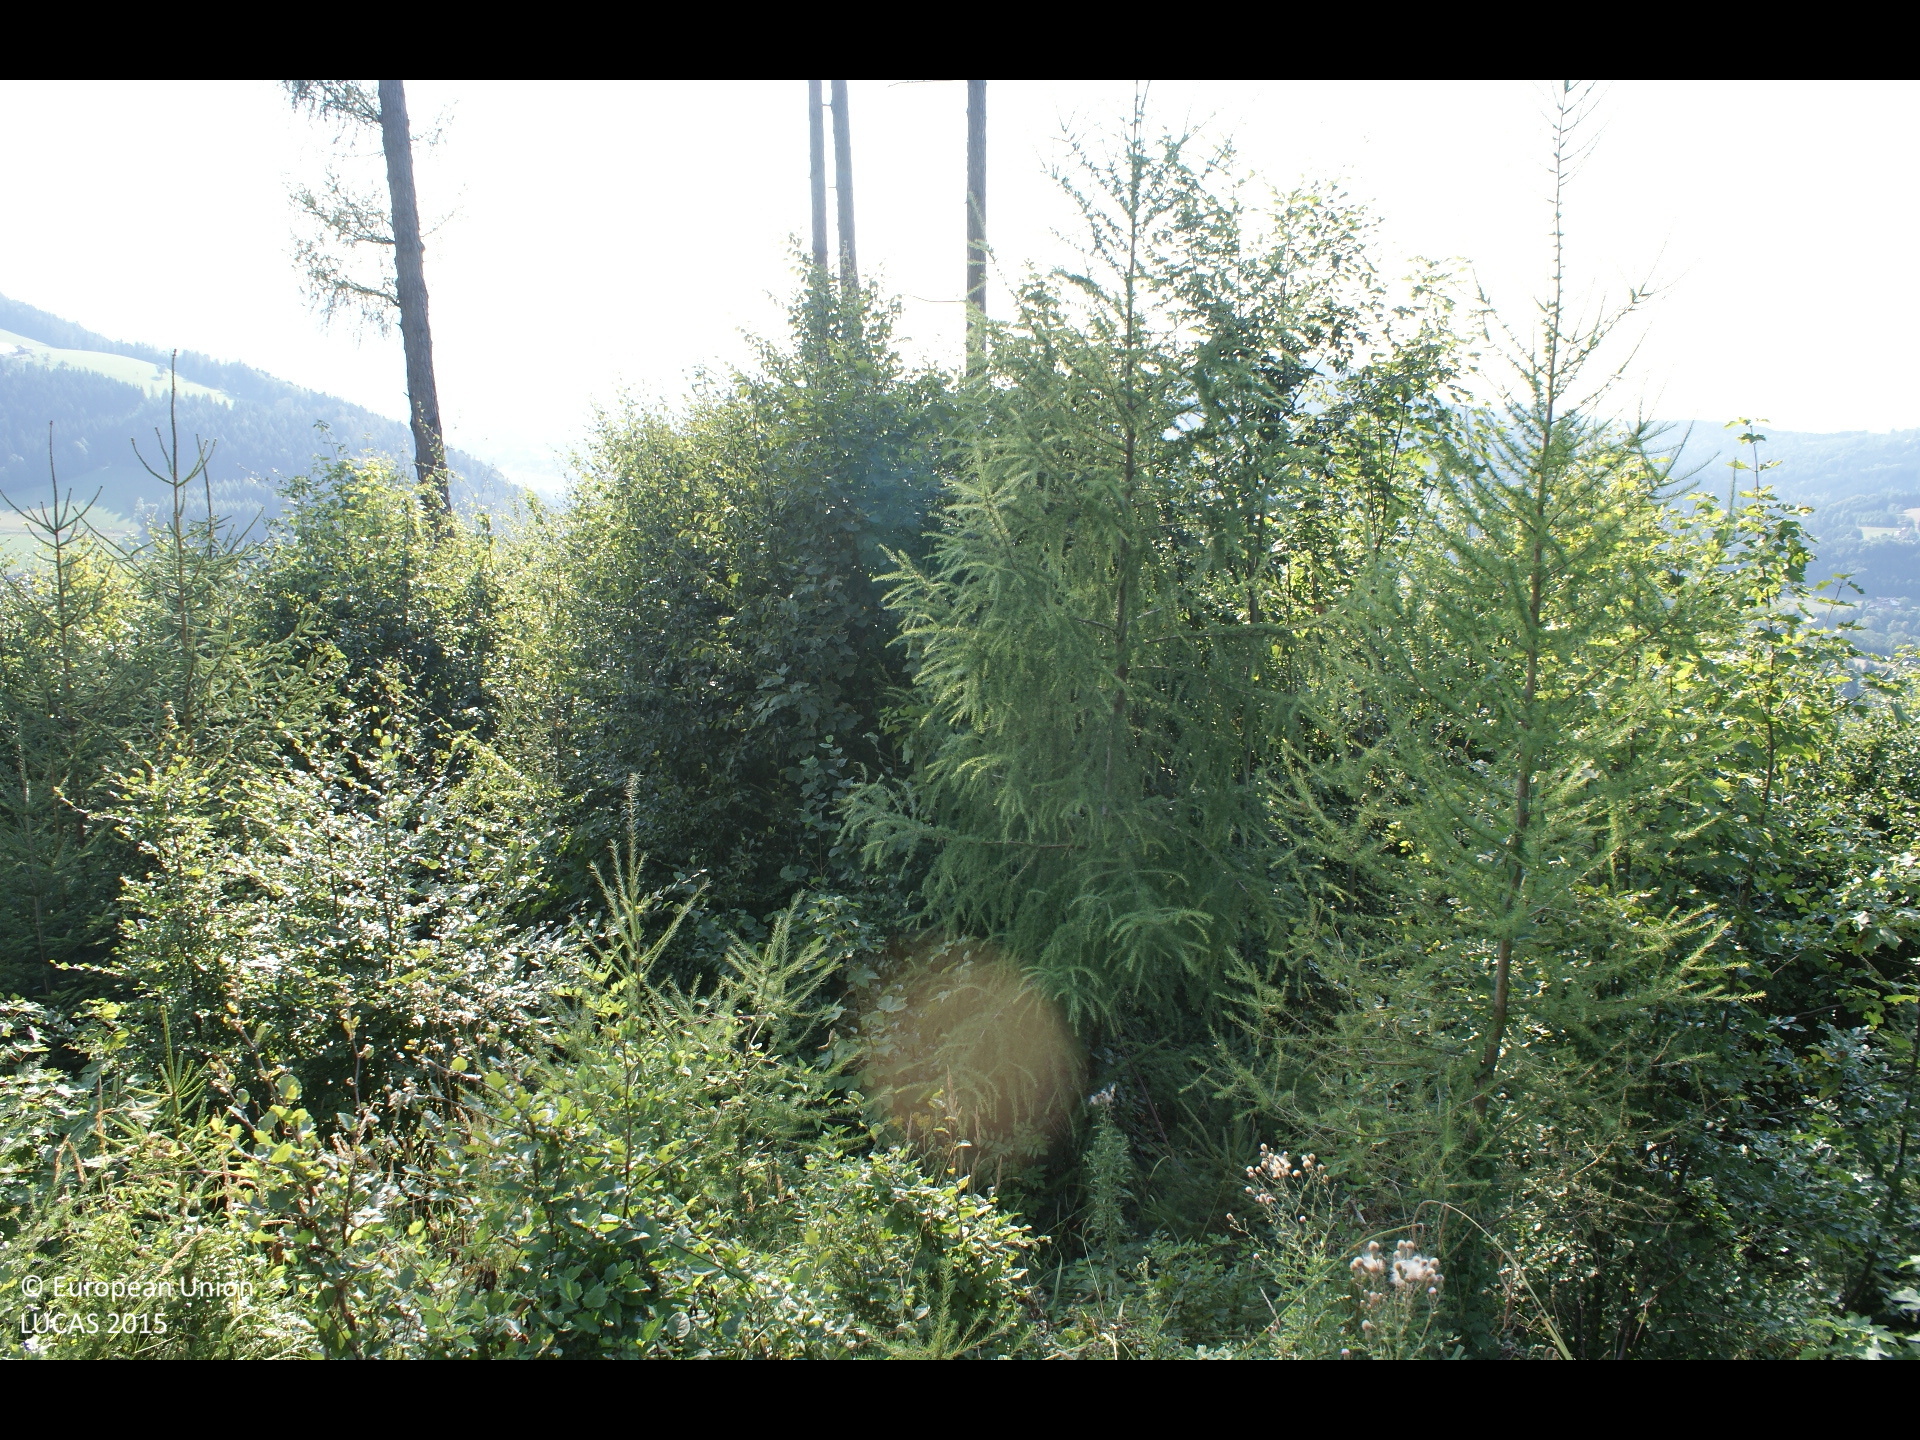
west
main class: Woodland
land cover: Spruce dominated mixed woodland
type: alpine coniferous forest
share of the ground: > 75 %
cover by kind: coniferous forest trees 65 %, broadleaved forest trees 25 %, shrubs 10 %
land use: Forestry
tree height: < 5 m
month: August
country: AT
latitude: 47.9168
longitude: 14.0003
